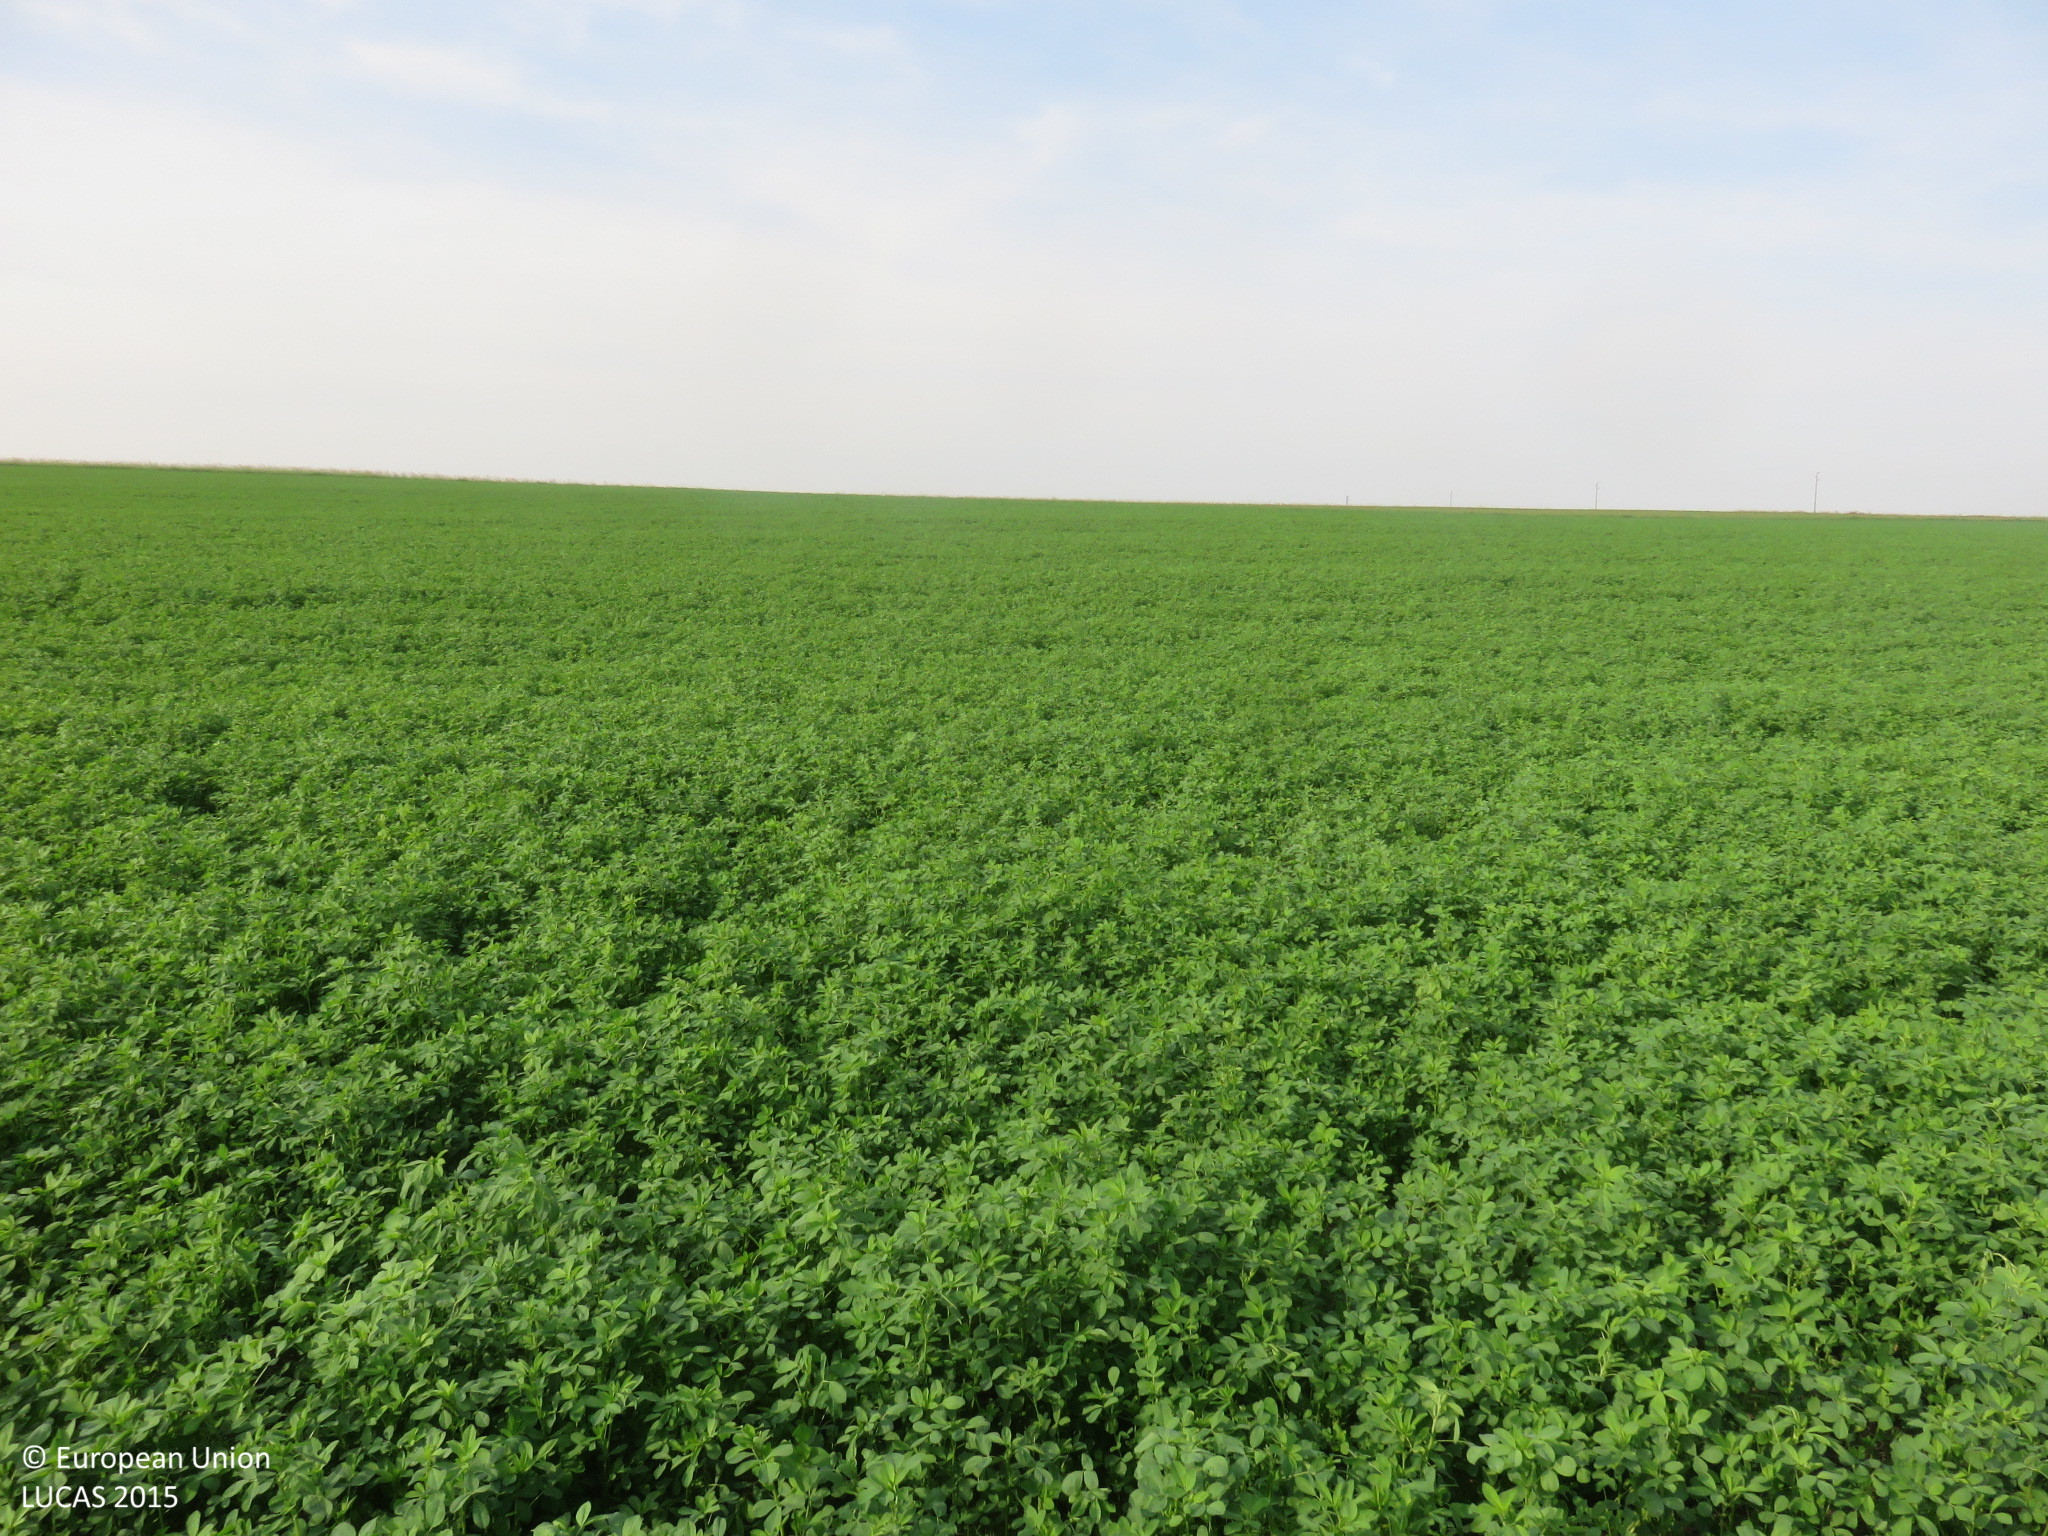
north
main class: Cropland
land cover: Lucerne
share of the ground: > 75 %
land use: Agriculture (excluding fallow land and kitchen gardens)
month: September
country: BG
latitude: 43.4106
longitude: 24.9250
